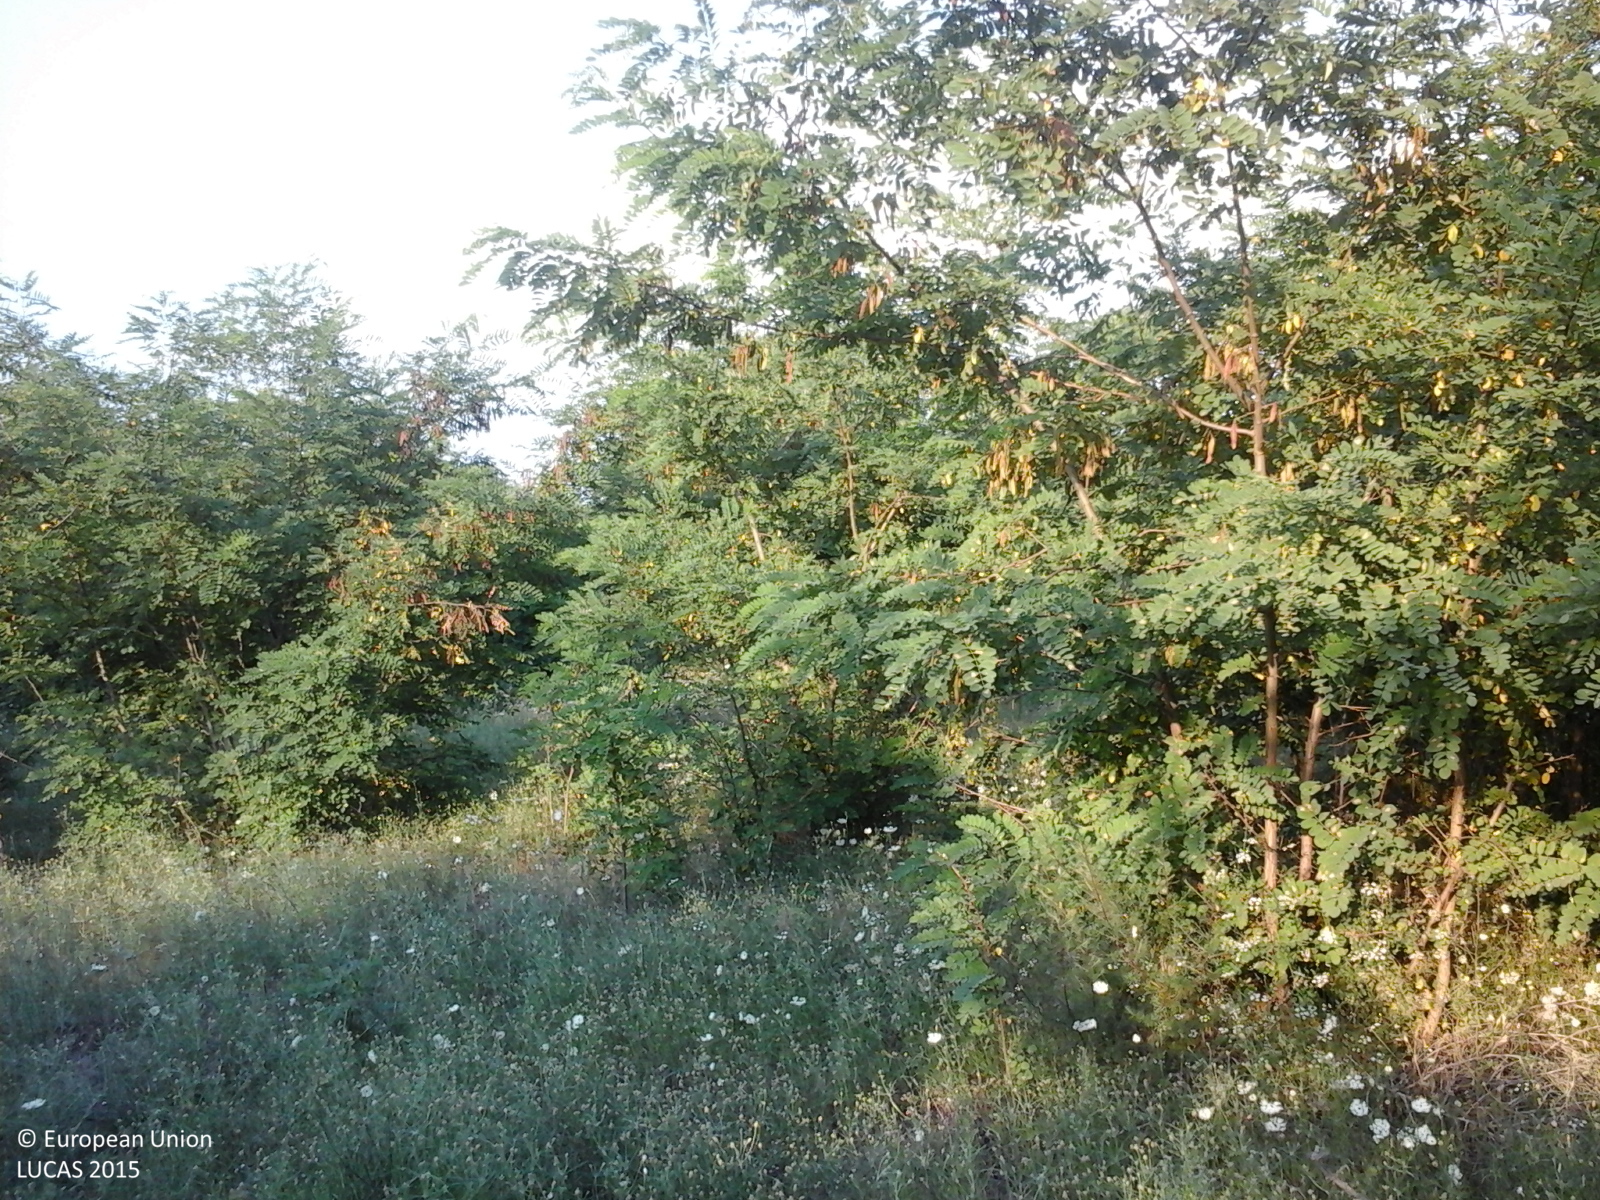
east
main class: Woodland
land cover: Broadleaved woodland
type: exotic forest
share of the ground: > 75 %
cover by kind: broadleaved forest trees 70 %, herbaceous plants 20 %, shrubs 10 %
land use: Forestry
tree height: > 5 m
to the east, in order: Broadleaved woodland; Grassland without tree/shrub cover; Grassland with sparse tree/shrub cover; Grassland without tree/shrub cover; Electric lines; Grassland without tree/shrub cover; Broadleaved woodland
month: July
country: RO
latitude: 43.7796
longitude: 24.1353
